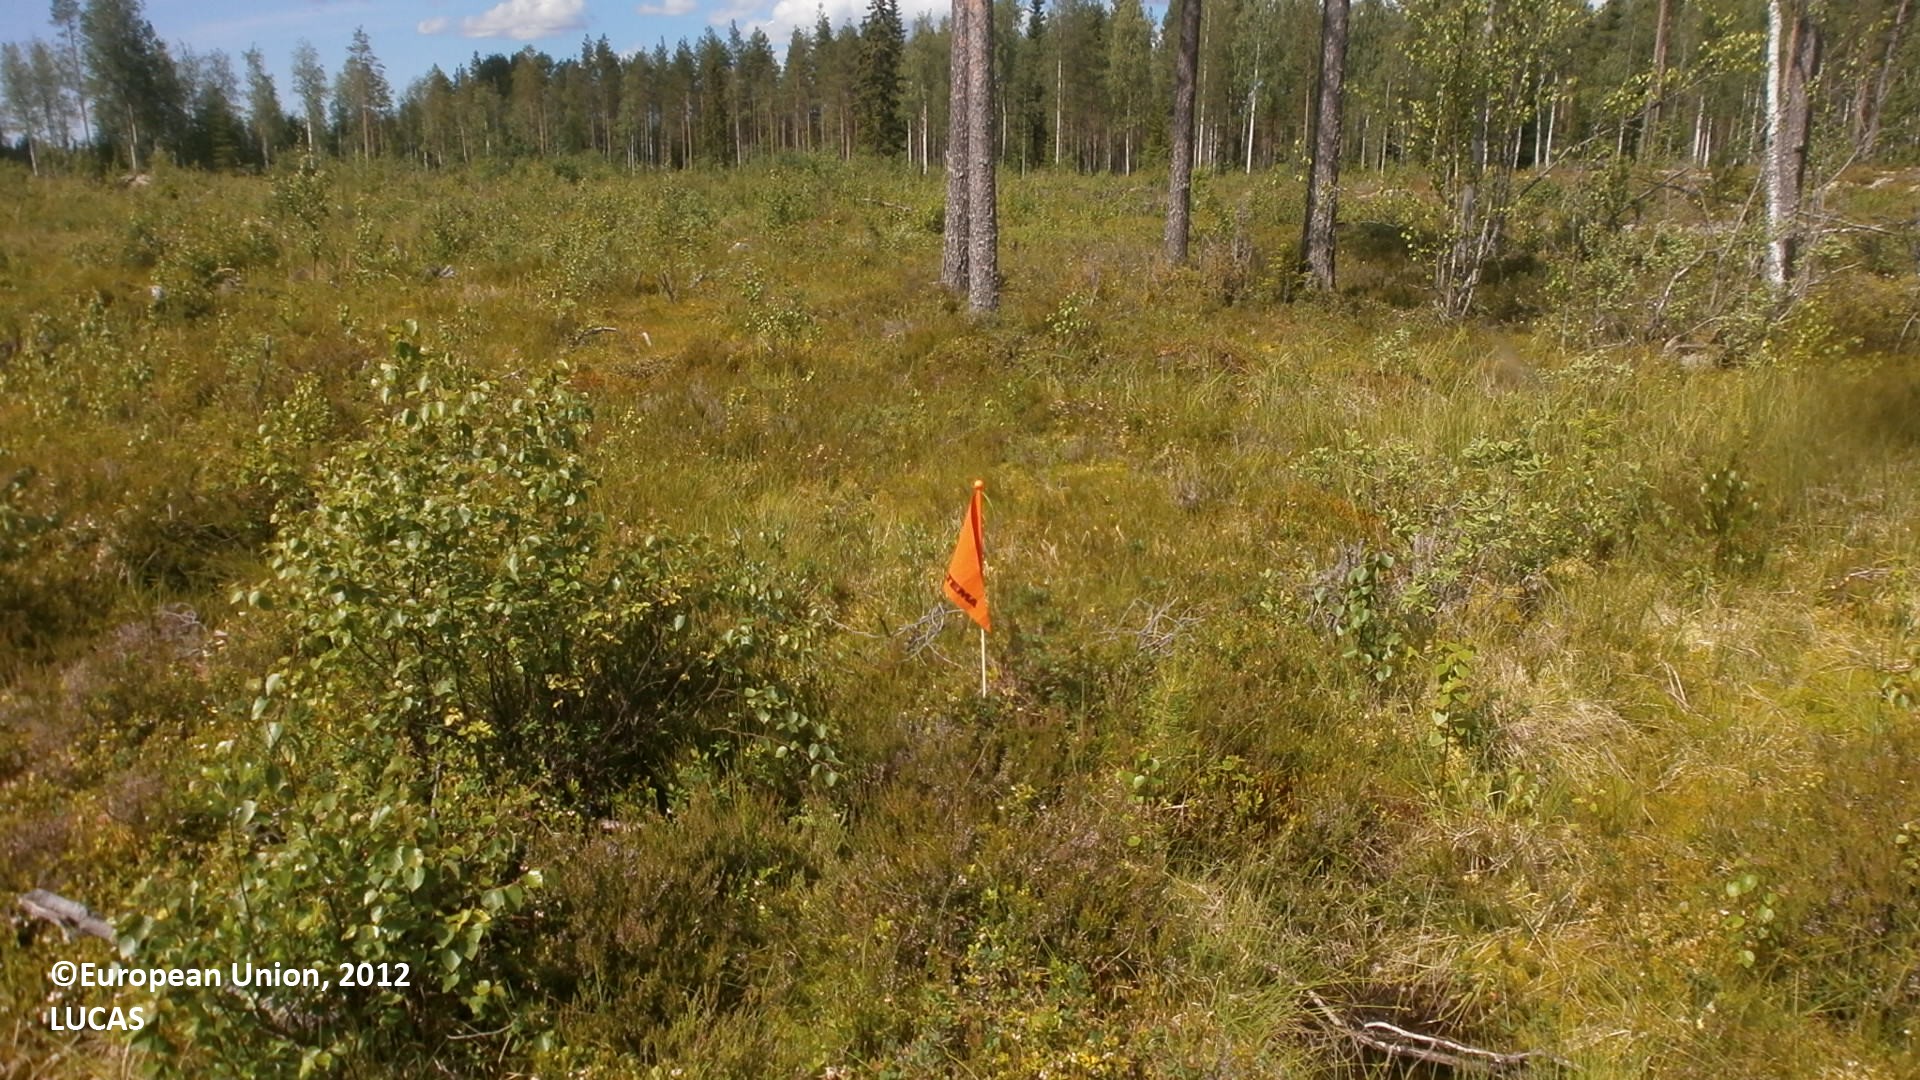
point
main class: Woodland
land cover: Other mixed woodland
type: boreal forest
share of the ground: 10 - 25 %
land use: Forestry
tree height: < 5 m
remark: Clear cut
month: July
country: FI
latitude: 64.1250
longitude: 24.9726
